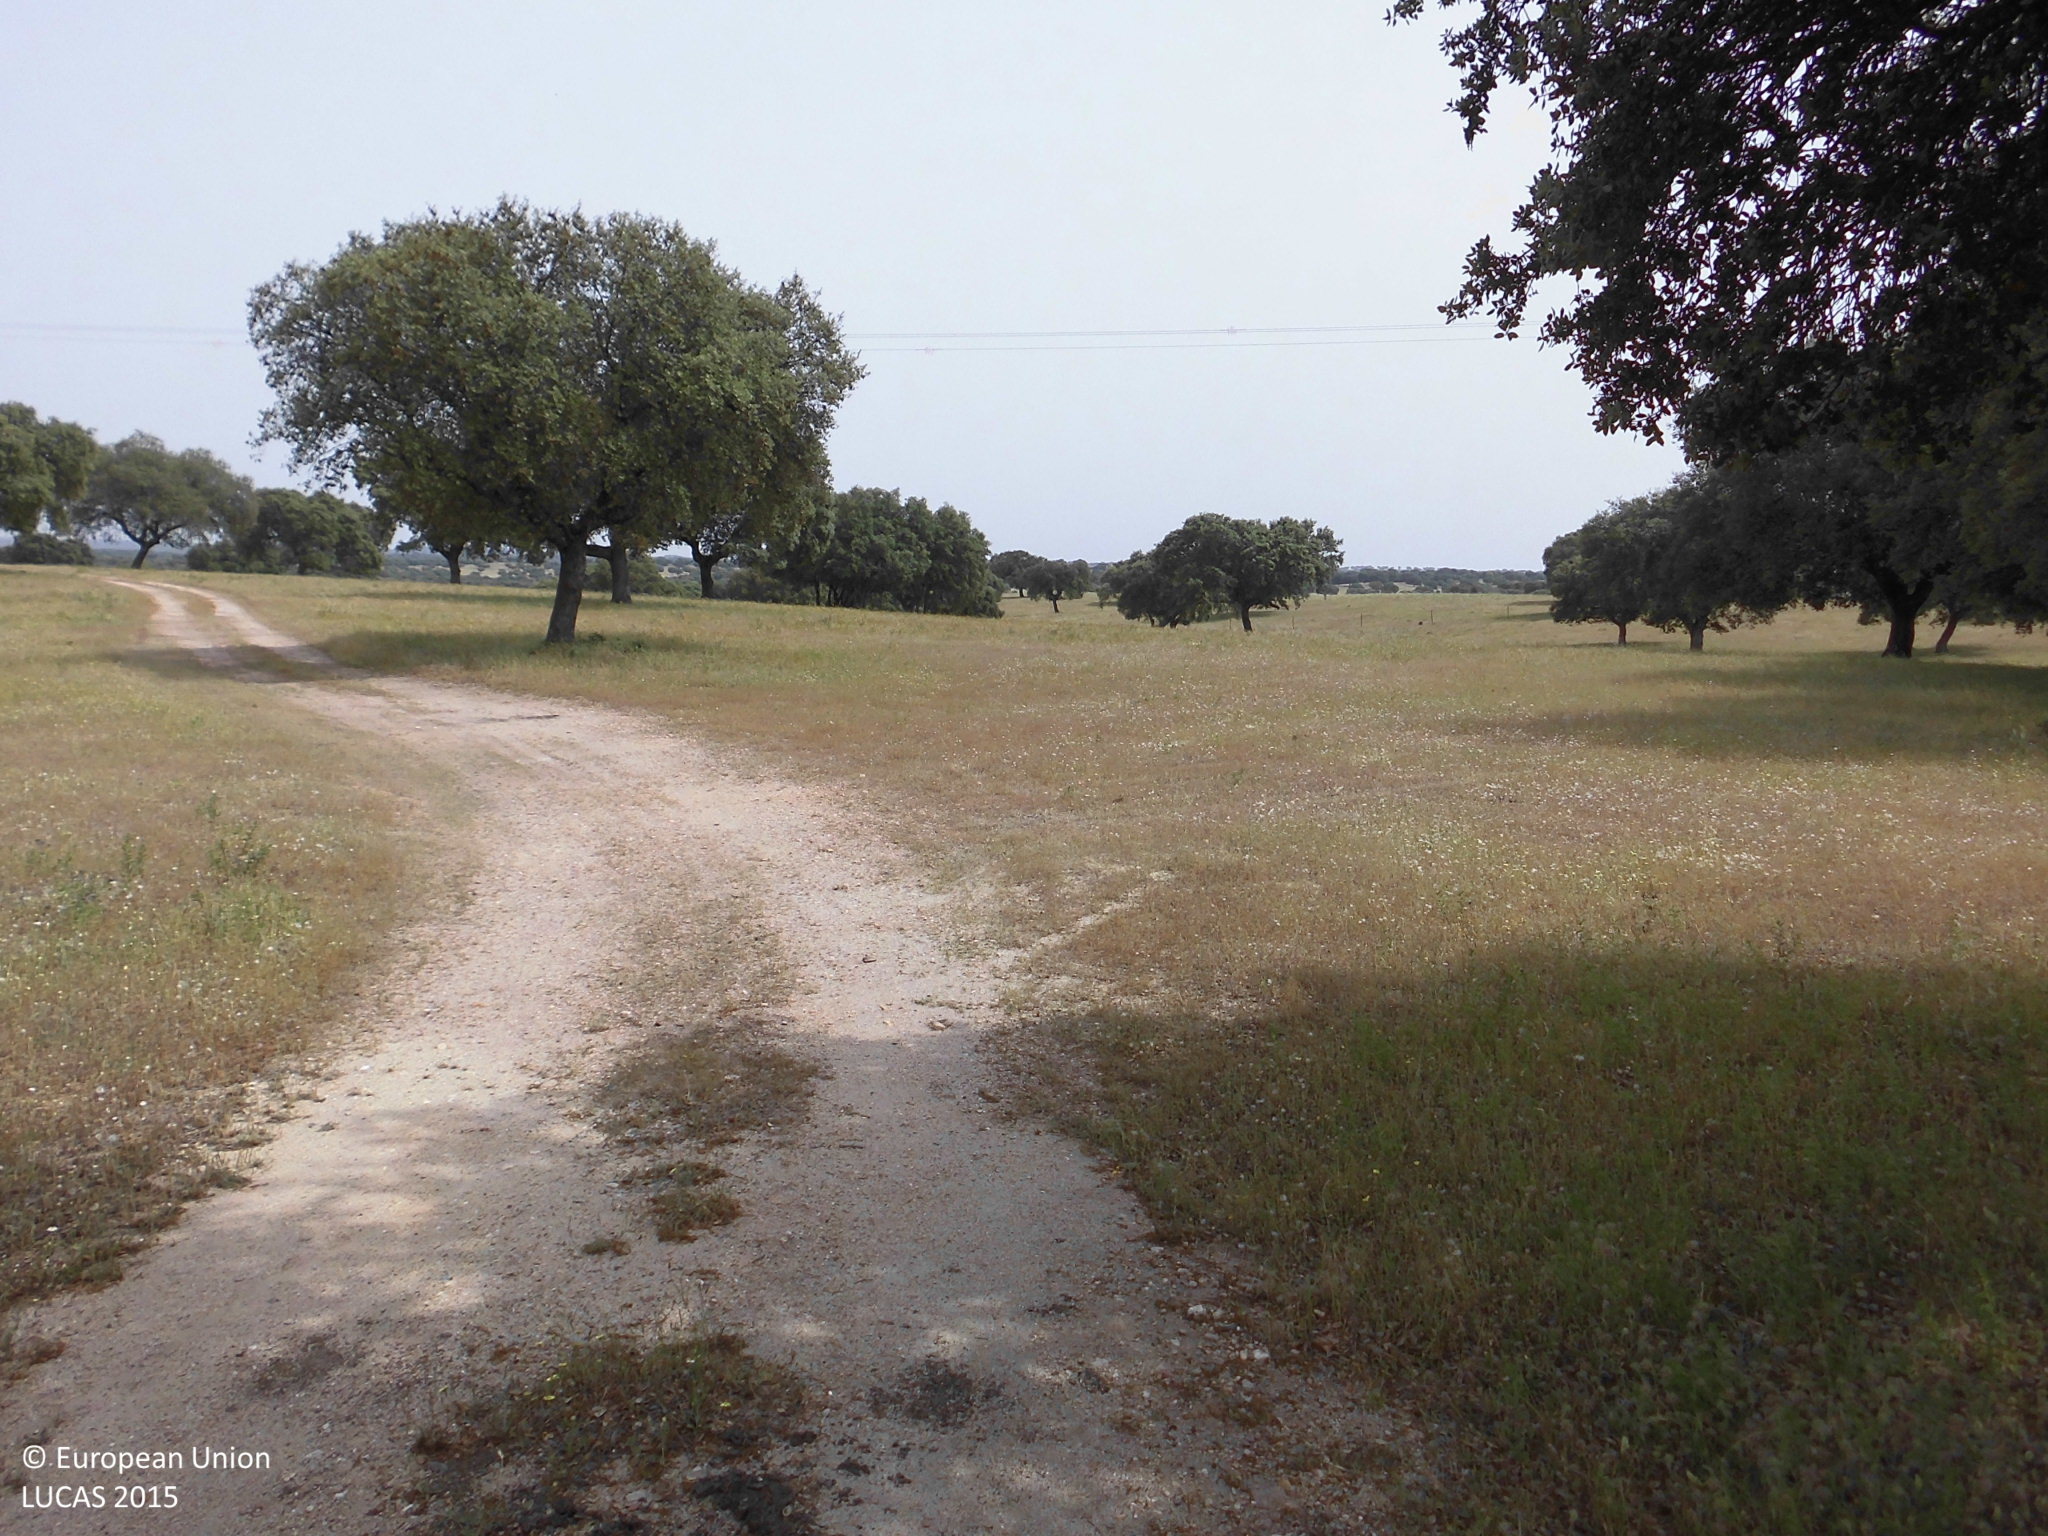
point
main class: Woodland
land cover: Broadleaved woodland
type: broadleaved evergreen forest
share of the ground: 10 - 25 %
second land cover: Grassland without tree/shrub cover
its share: > 75 %
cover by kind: herbaceous plants 90 %, broadleaved forest trees 10 %
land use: Forestry
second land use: Agriculture (excluding fallow land and kitchen gardens)
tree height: > 5 m
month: May
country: ES
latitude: 39.7182
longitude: -6.1068
